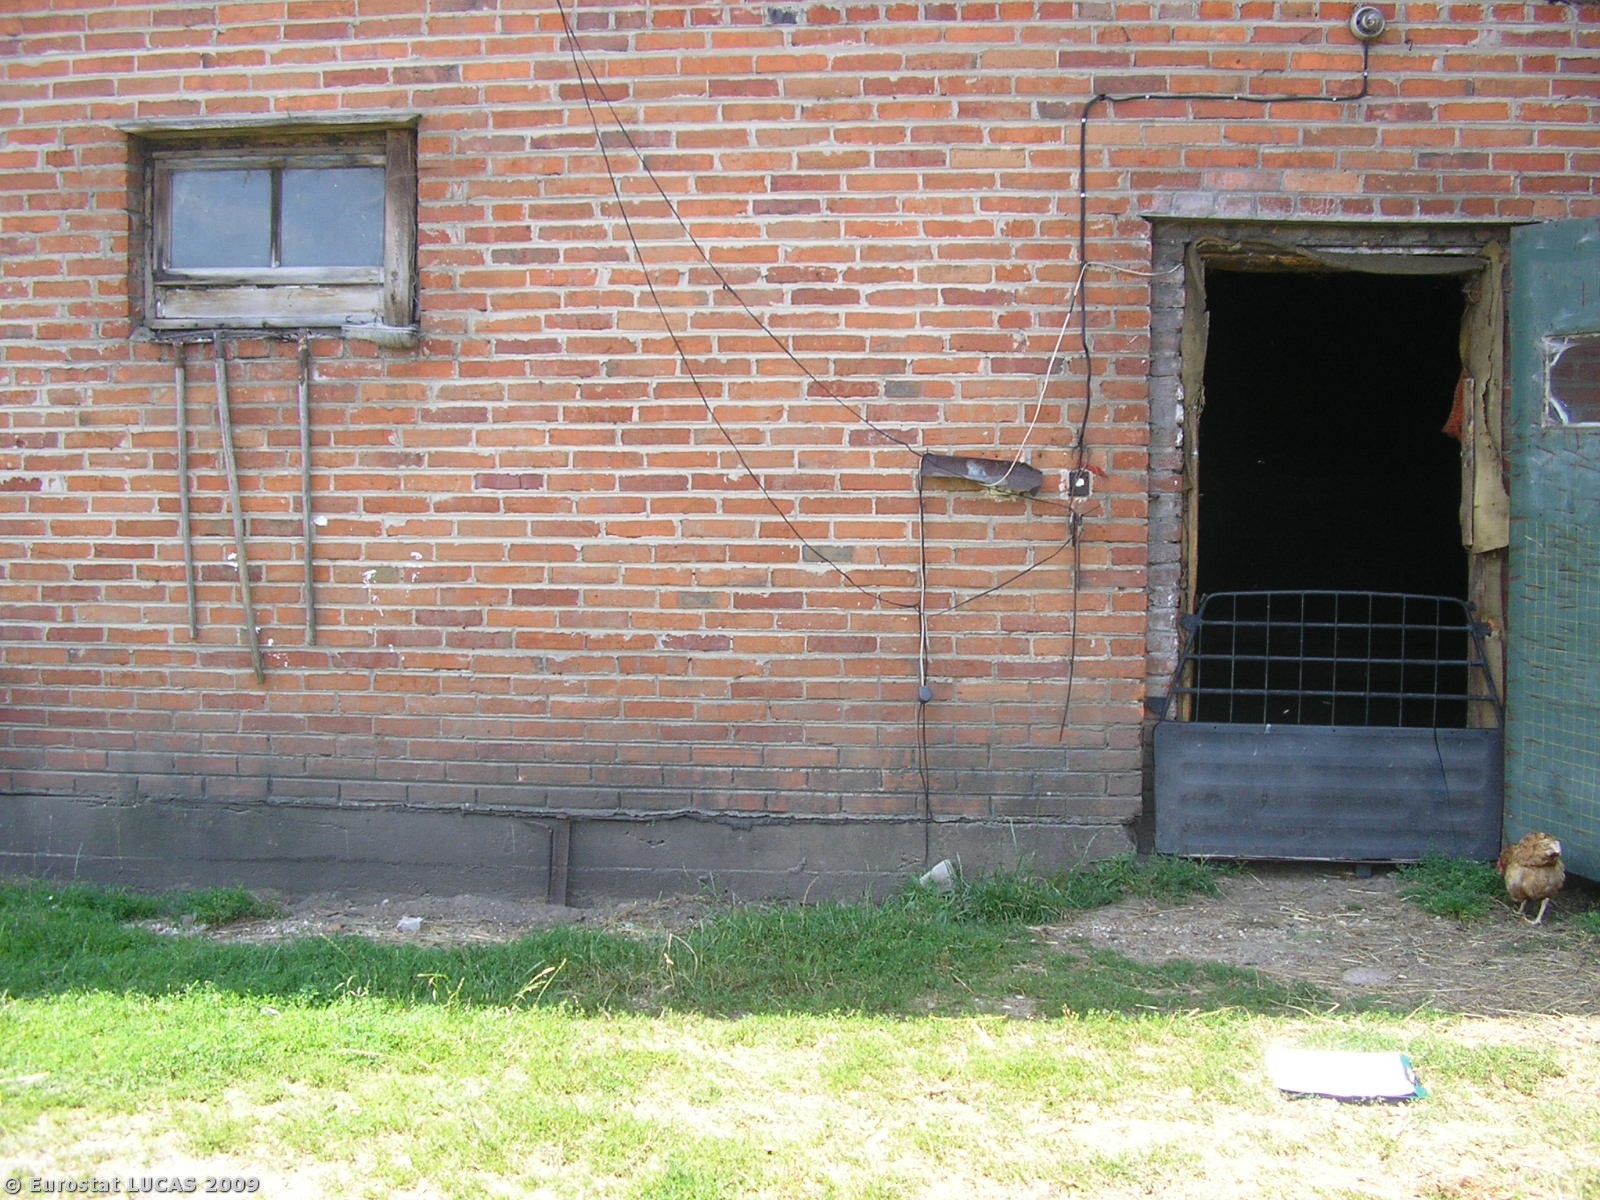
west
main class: Grassland
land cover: Grassland without tree/shrub cover
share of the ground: > 75 %
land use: Residential
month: July
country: PL
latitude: 52.0359
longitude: 22.2047
